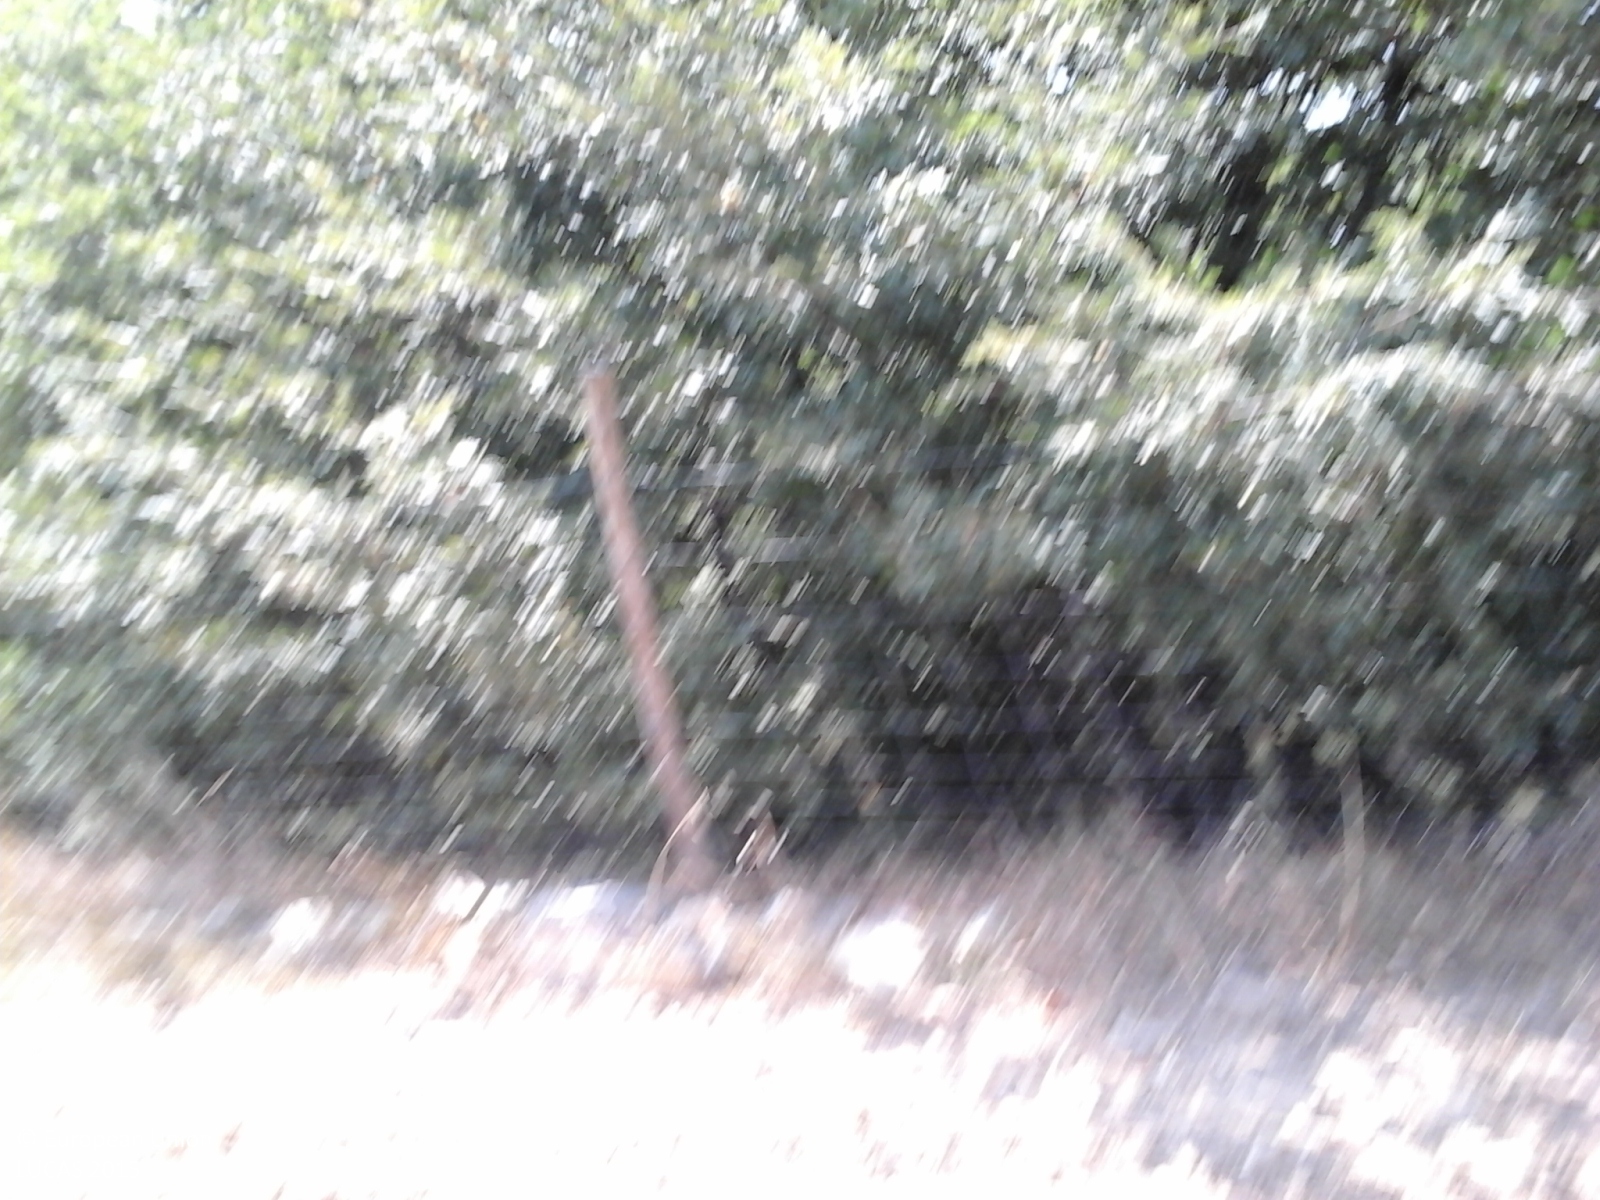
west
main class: Woodland
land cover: Broadleaved woodland
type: thermophilous deciduous forest
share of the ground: > 75 %
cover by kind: broadleaved forest trees 75 %, shrubs 20 %, herbaceous plants 5 %
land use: Forestry
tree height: > 5 m
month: July
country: IT
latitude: 43.0571
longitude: 11.5791
